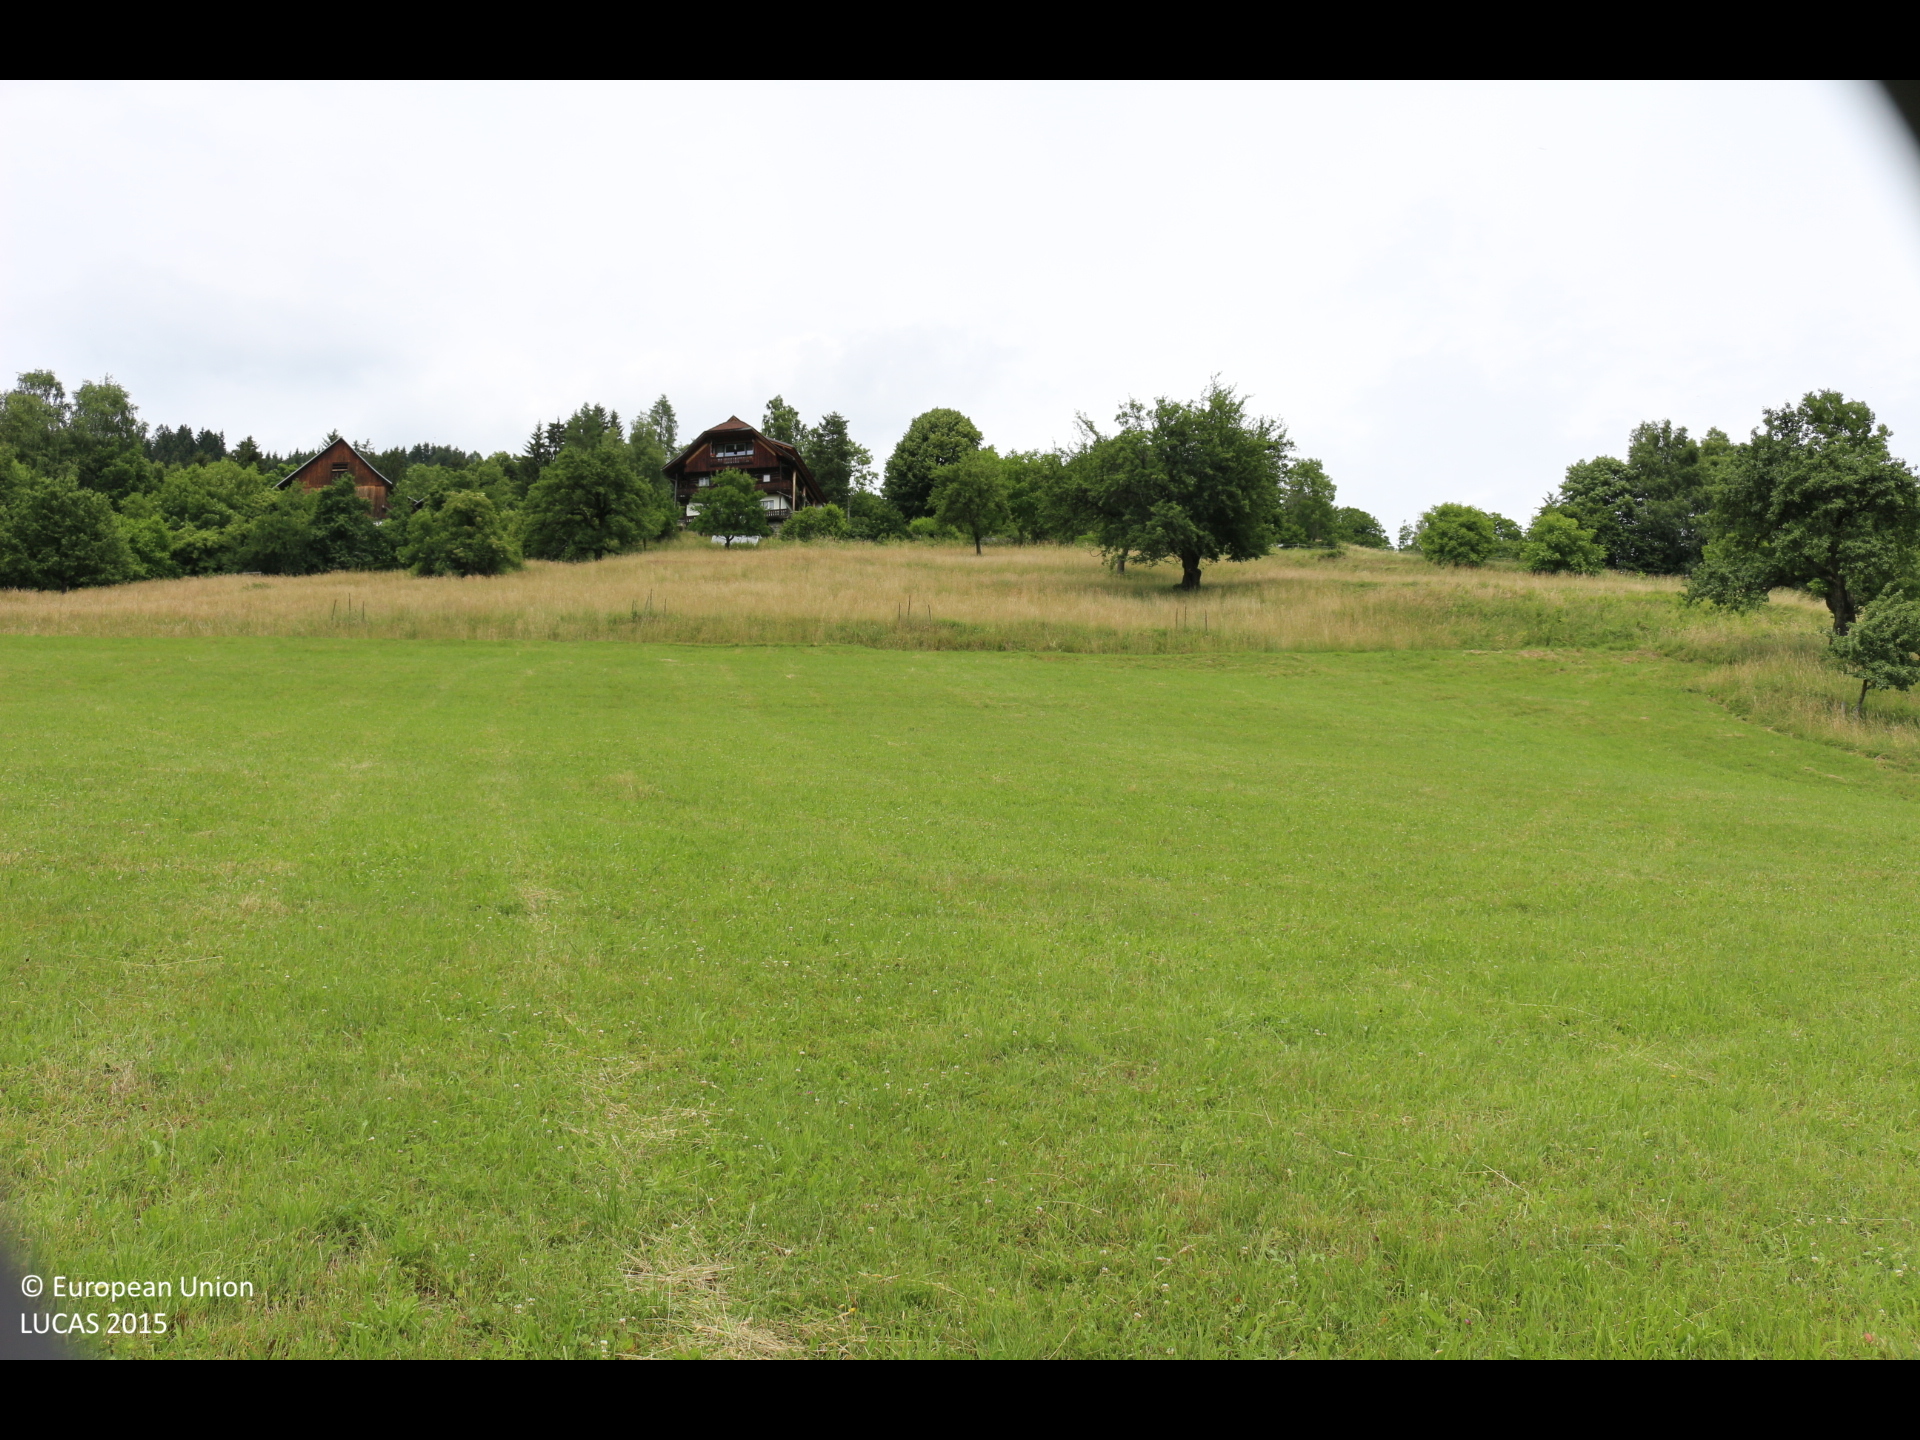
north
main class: Grassland
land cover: Grassland without tree/shrub cover
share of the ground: > 75 %
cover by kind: herbaceous plants 100 %
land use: Agriculture (excluding fallow land and kitchen gardens)
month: June
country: AT
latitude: 46.6927
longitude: 13.9596
